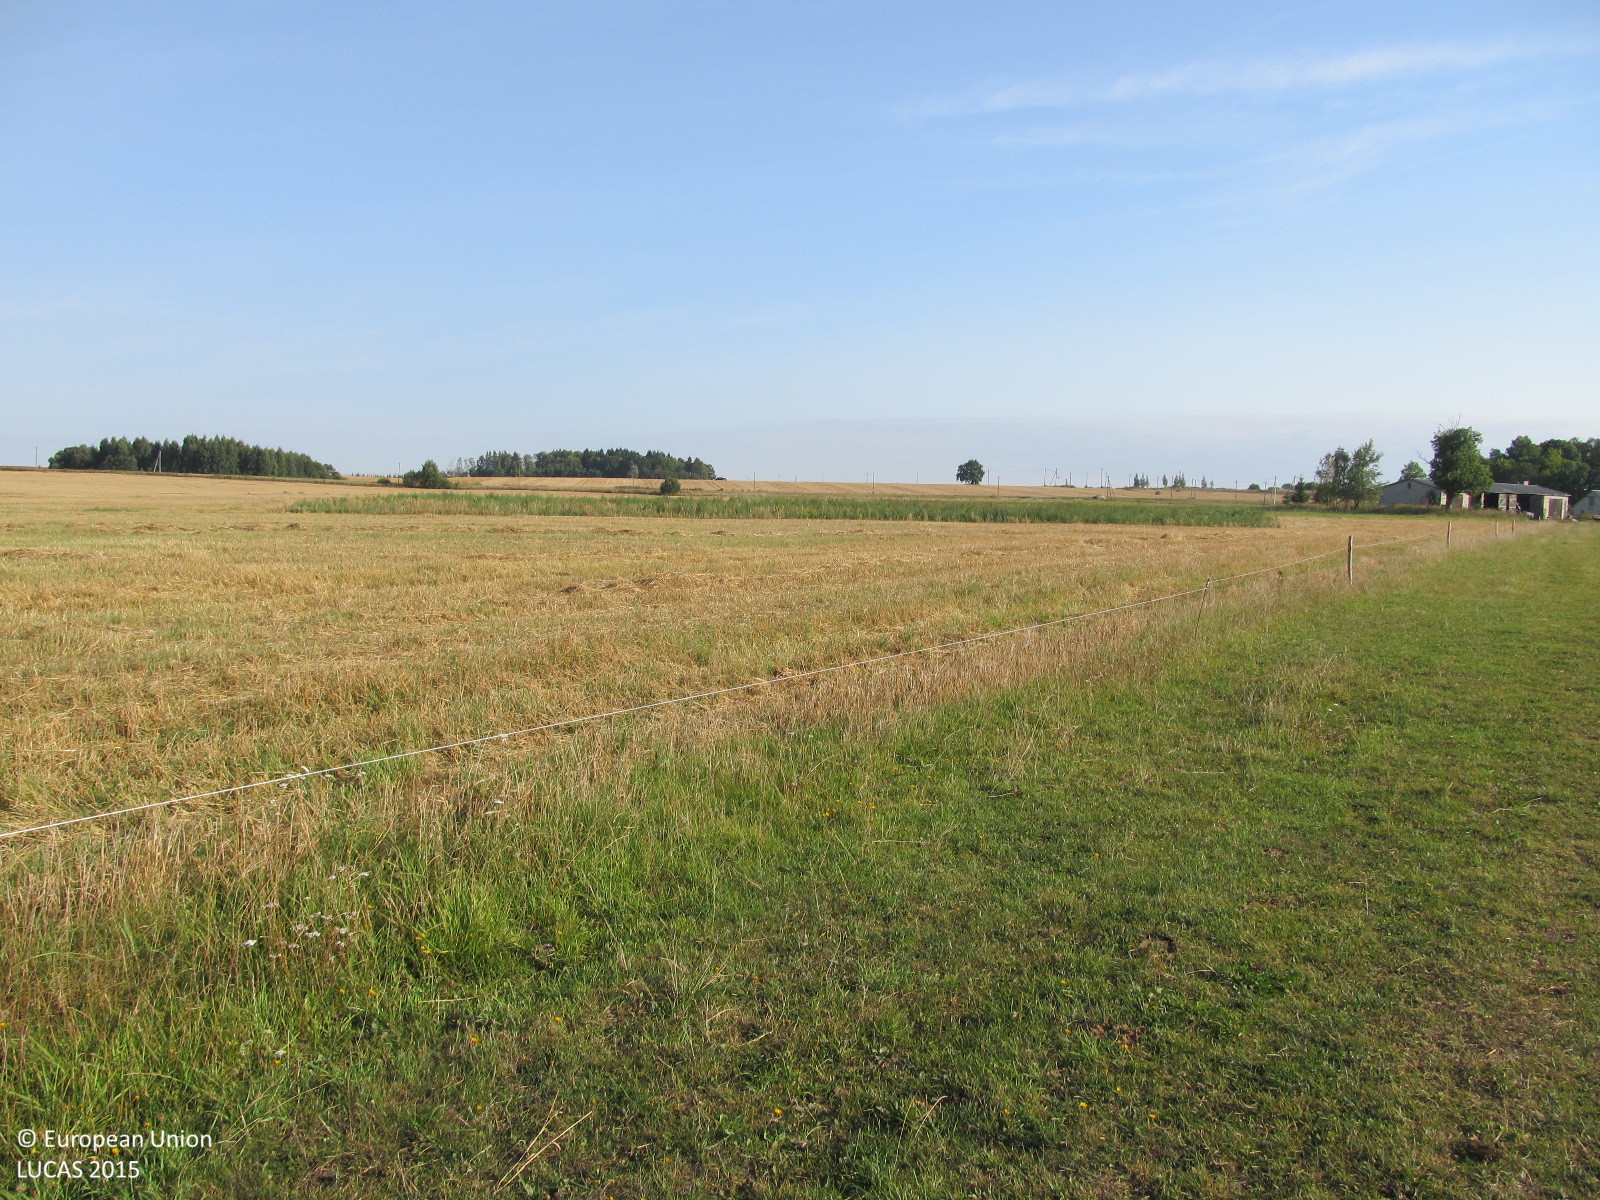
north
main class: Grassland
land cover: Grassland without tree/shrub cover
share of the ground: > 75 %
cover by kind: herbaceous plants 100 %
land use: Agriculture (excluding fallow land and kitchen gardens)
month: August
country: LT
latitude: 55.9160
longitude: 23.0776
